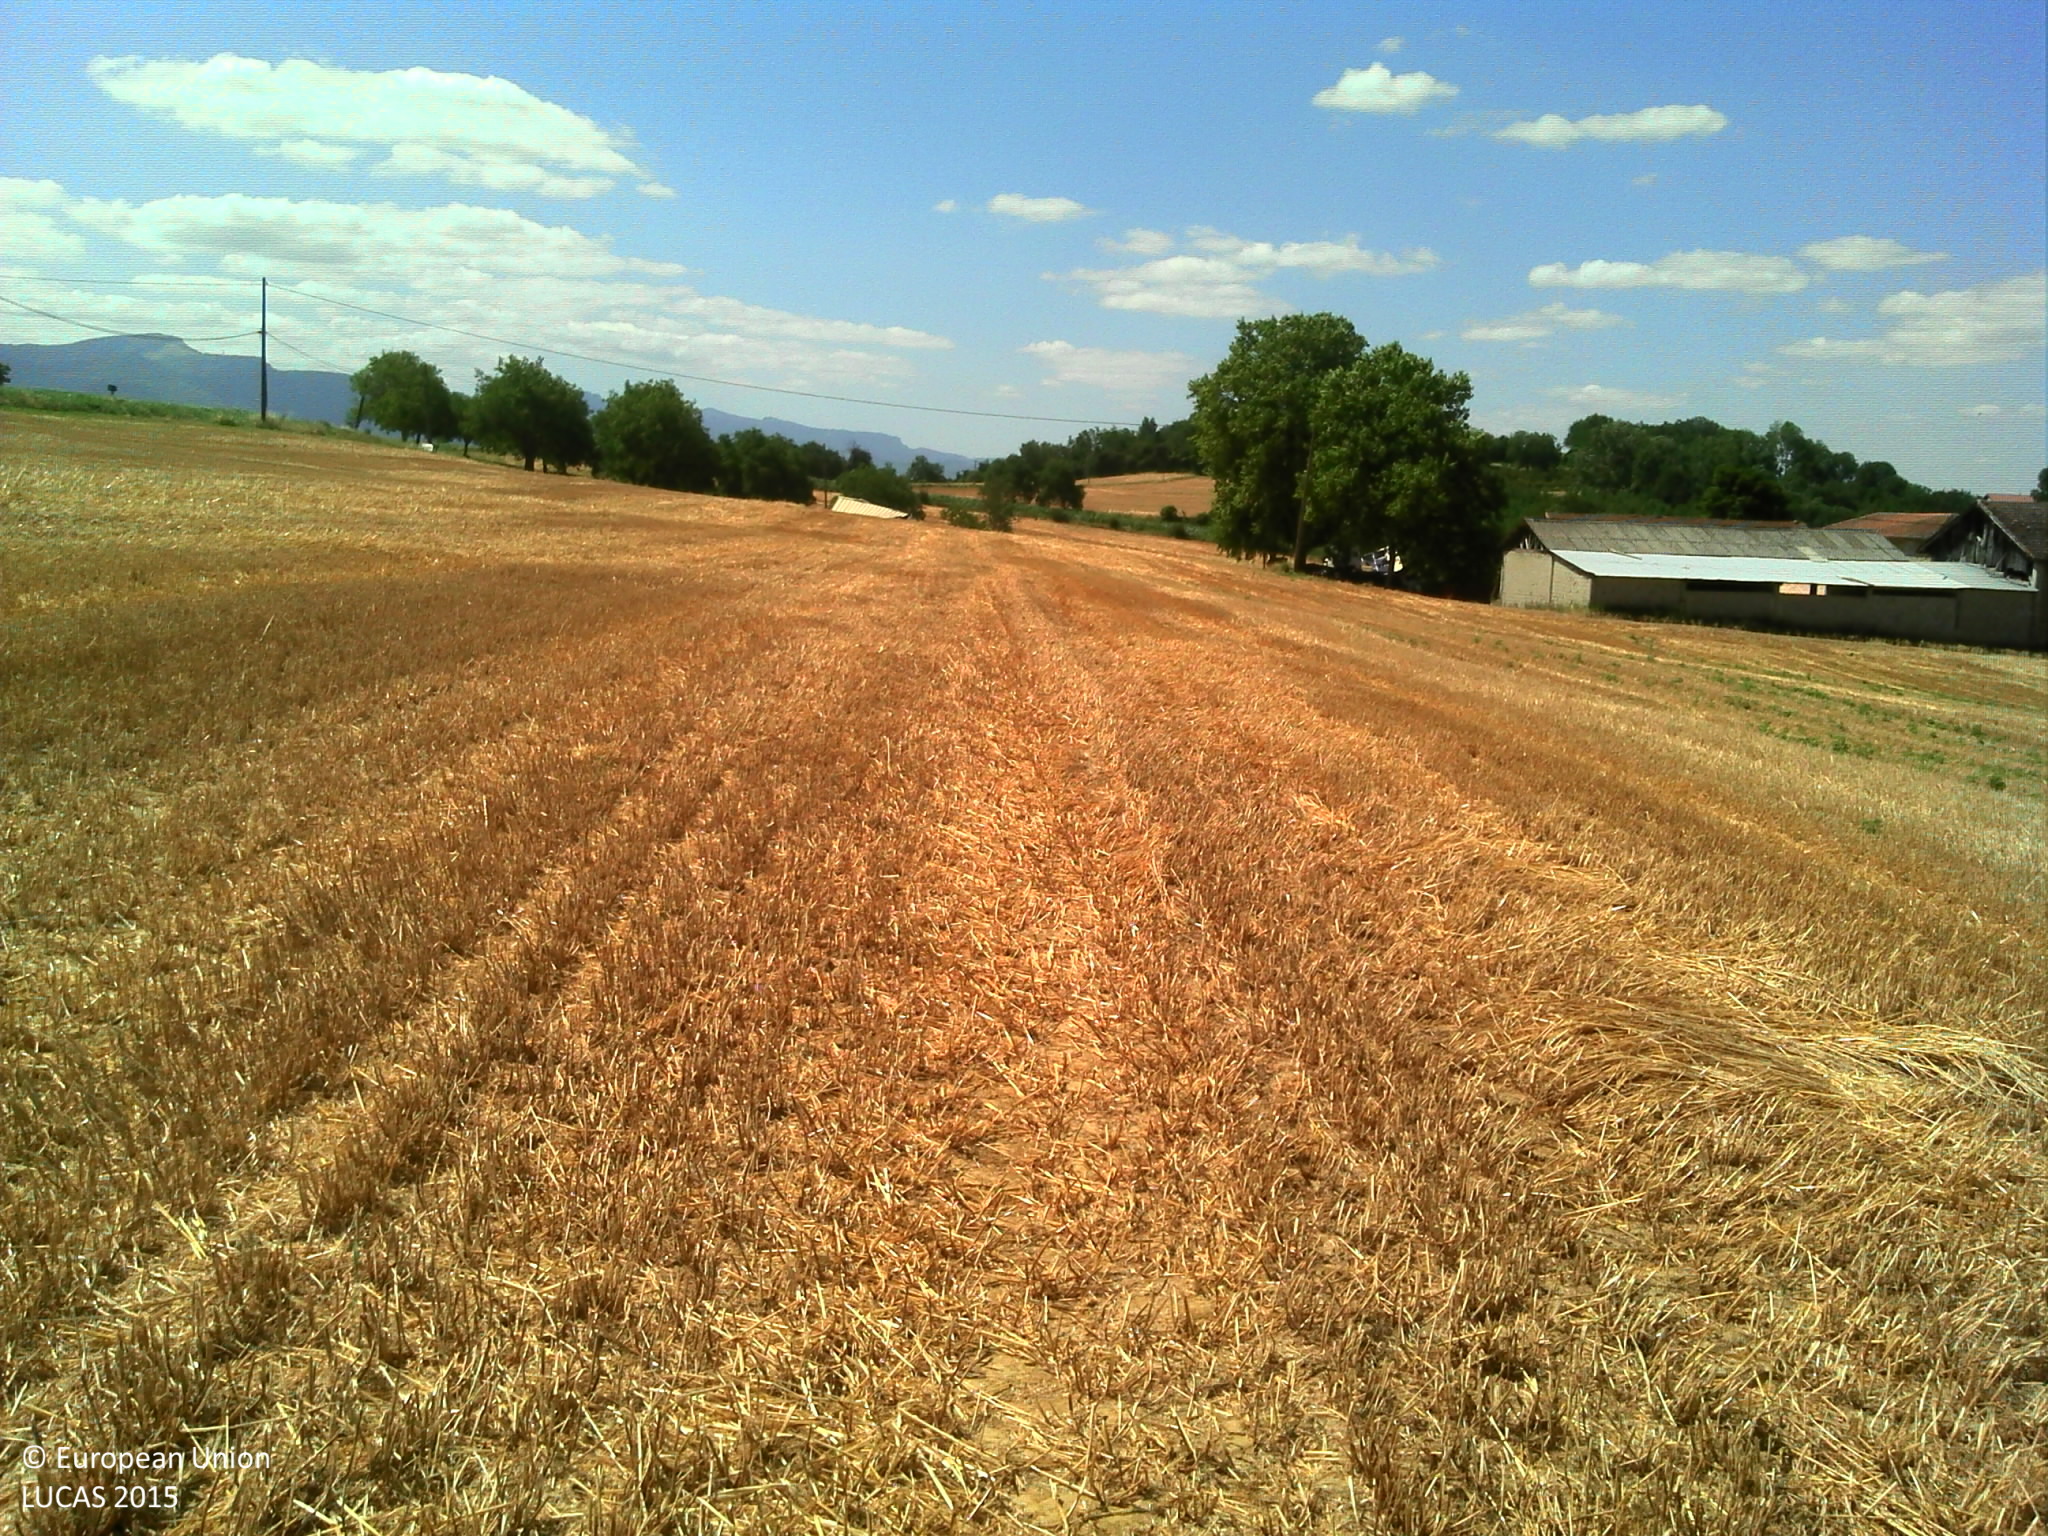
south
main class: Cropland
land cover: Barley
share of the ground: > 75 %
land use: Agriculture (excluding fallow land and kitchen gardens)
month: July
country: FR
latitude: 45.1239
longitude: 5.1871
